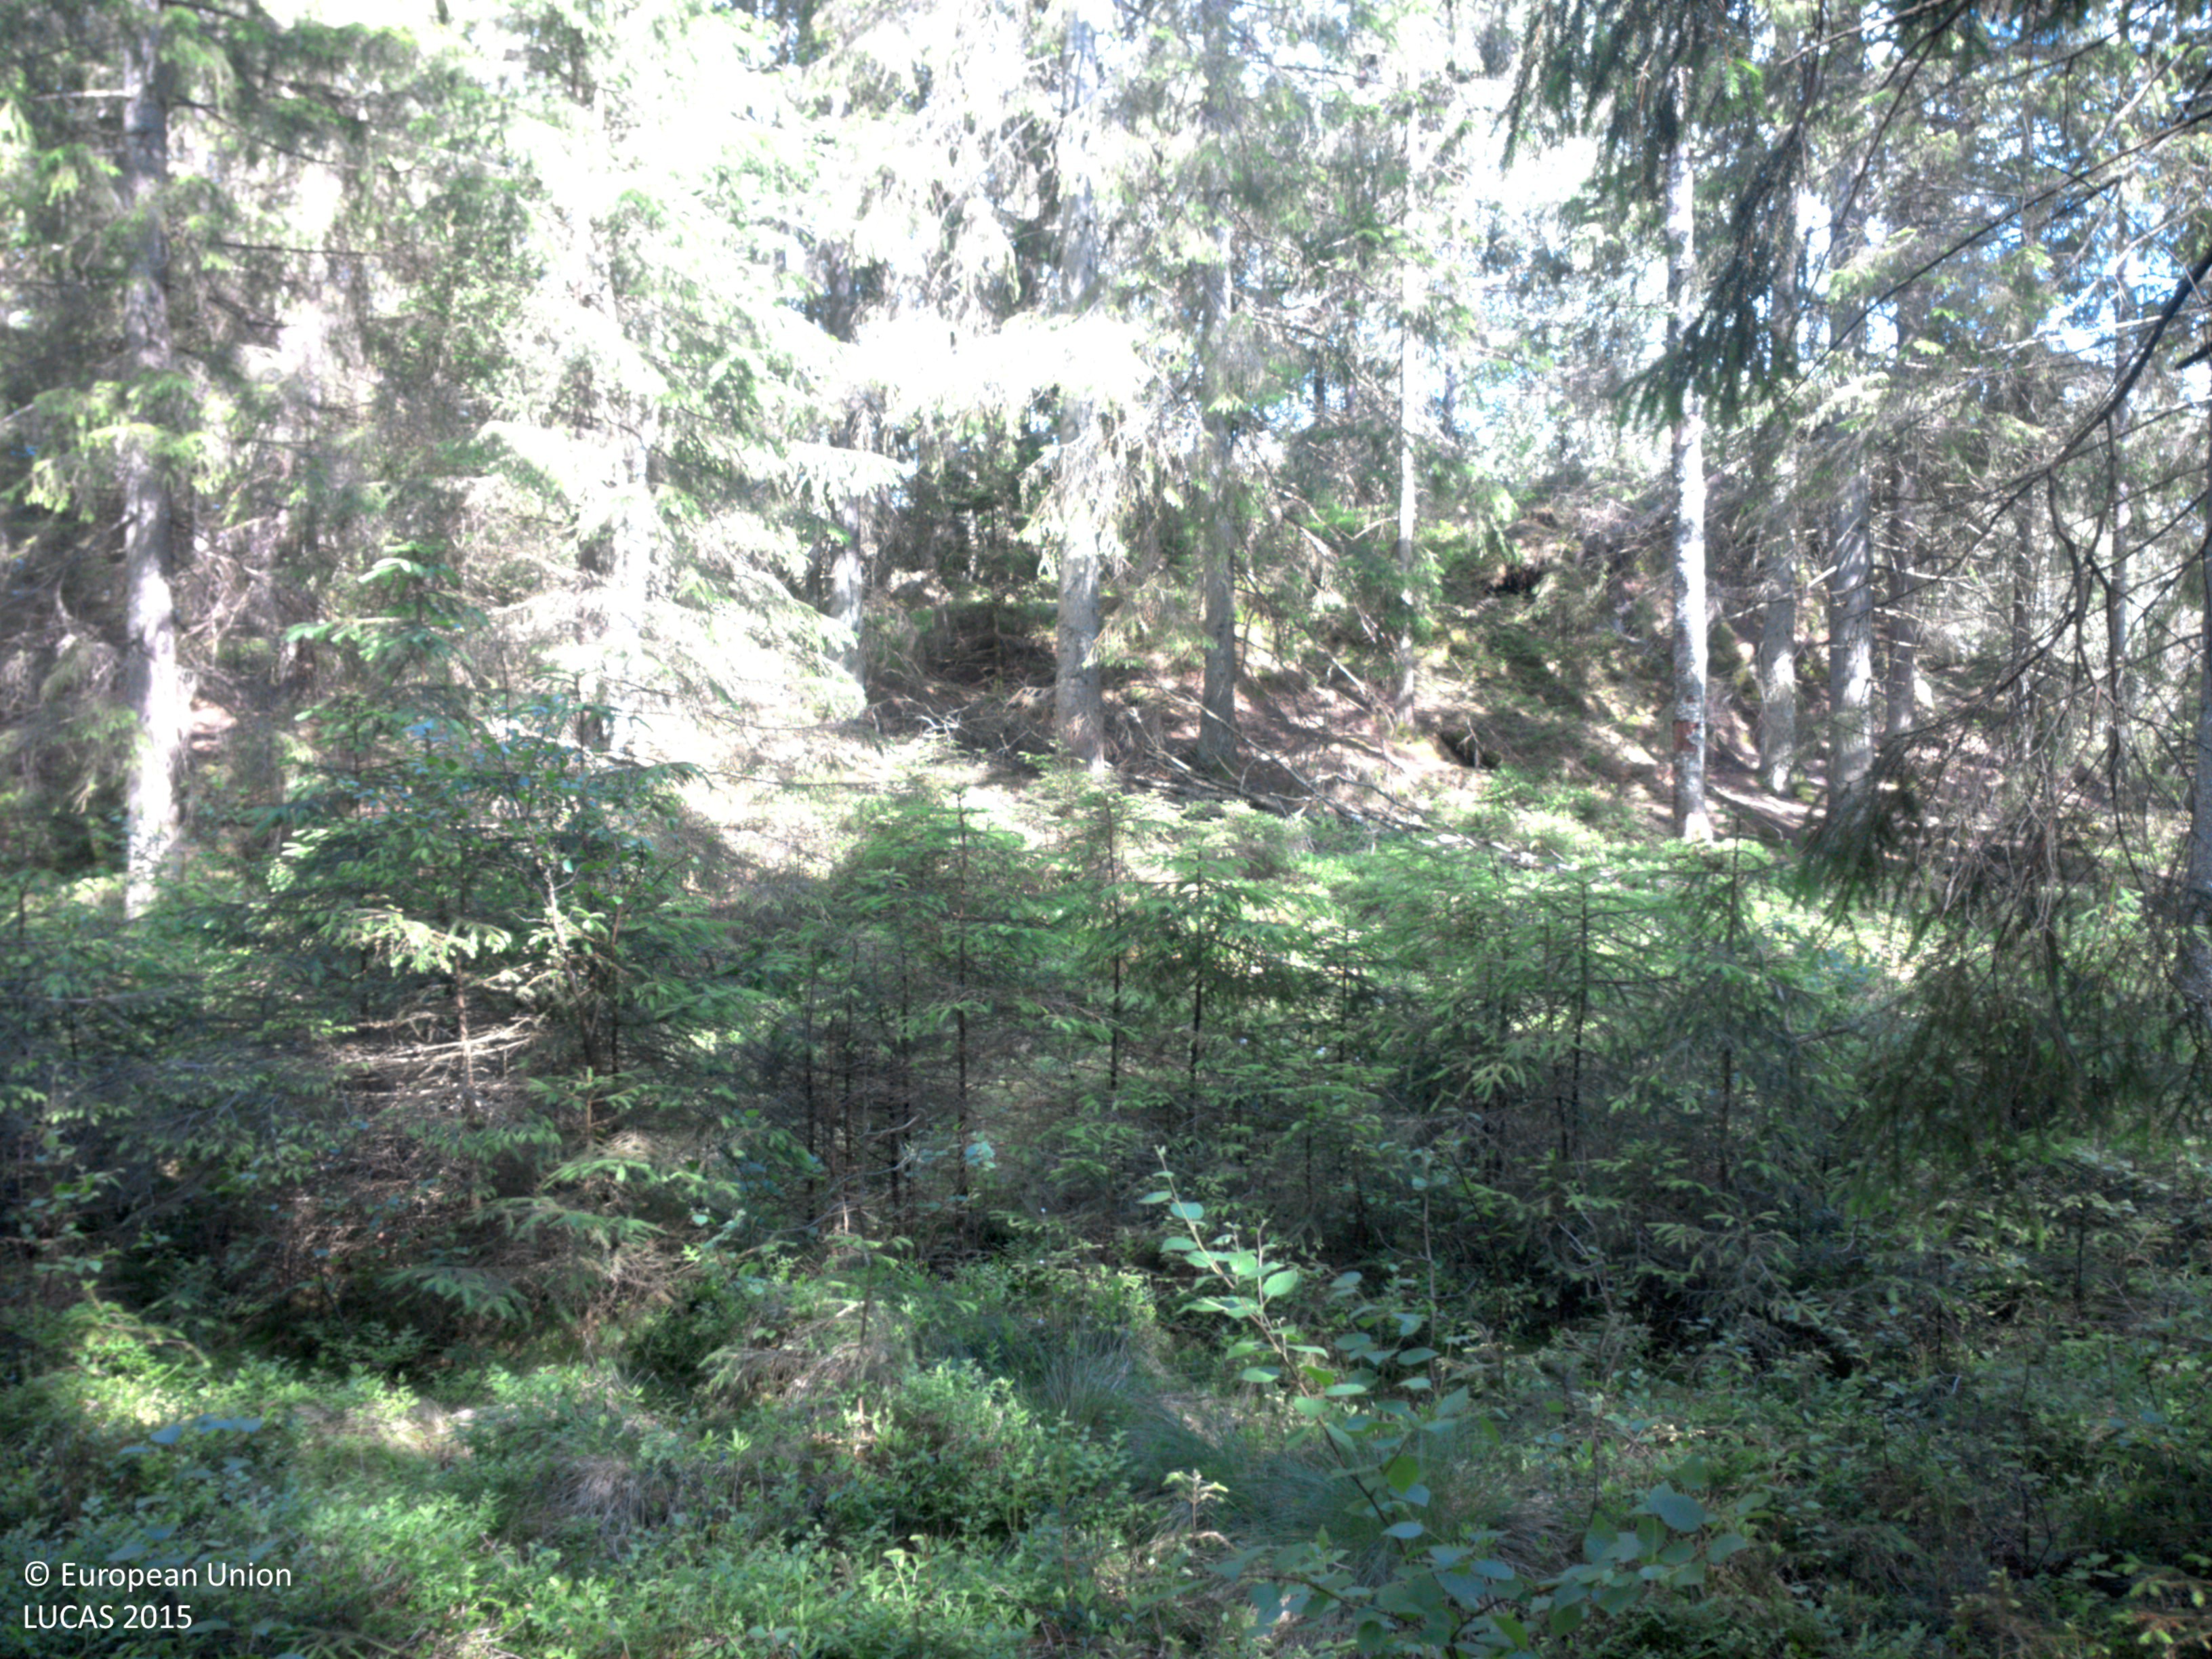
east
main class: Woodland
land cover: Spruce dominated coniferous woodland
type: boreal forest
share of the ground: 50 - 75 %
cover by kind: coniferous forest trees 55 %, shrubs 25 %, herbaceous plants 10 %, broadleaved forest trees 5 %, lichens and mosses 5 %
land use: Forestry
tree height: > 5 m
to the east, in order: Spruce dominated coniferous woodland; Tracks; Grassland without tree/shrub cover; Ditches and canals; Spruce dominated mixed woodland; Spruce dominated coniferous woodland; Broadleaved woodland; Grassland without tree/shrub cover; Ditches and canals; Grassland without tree/shrub cover
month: June
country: SE
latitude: 58.5514
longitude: 11.6290
